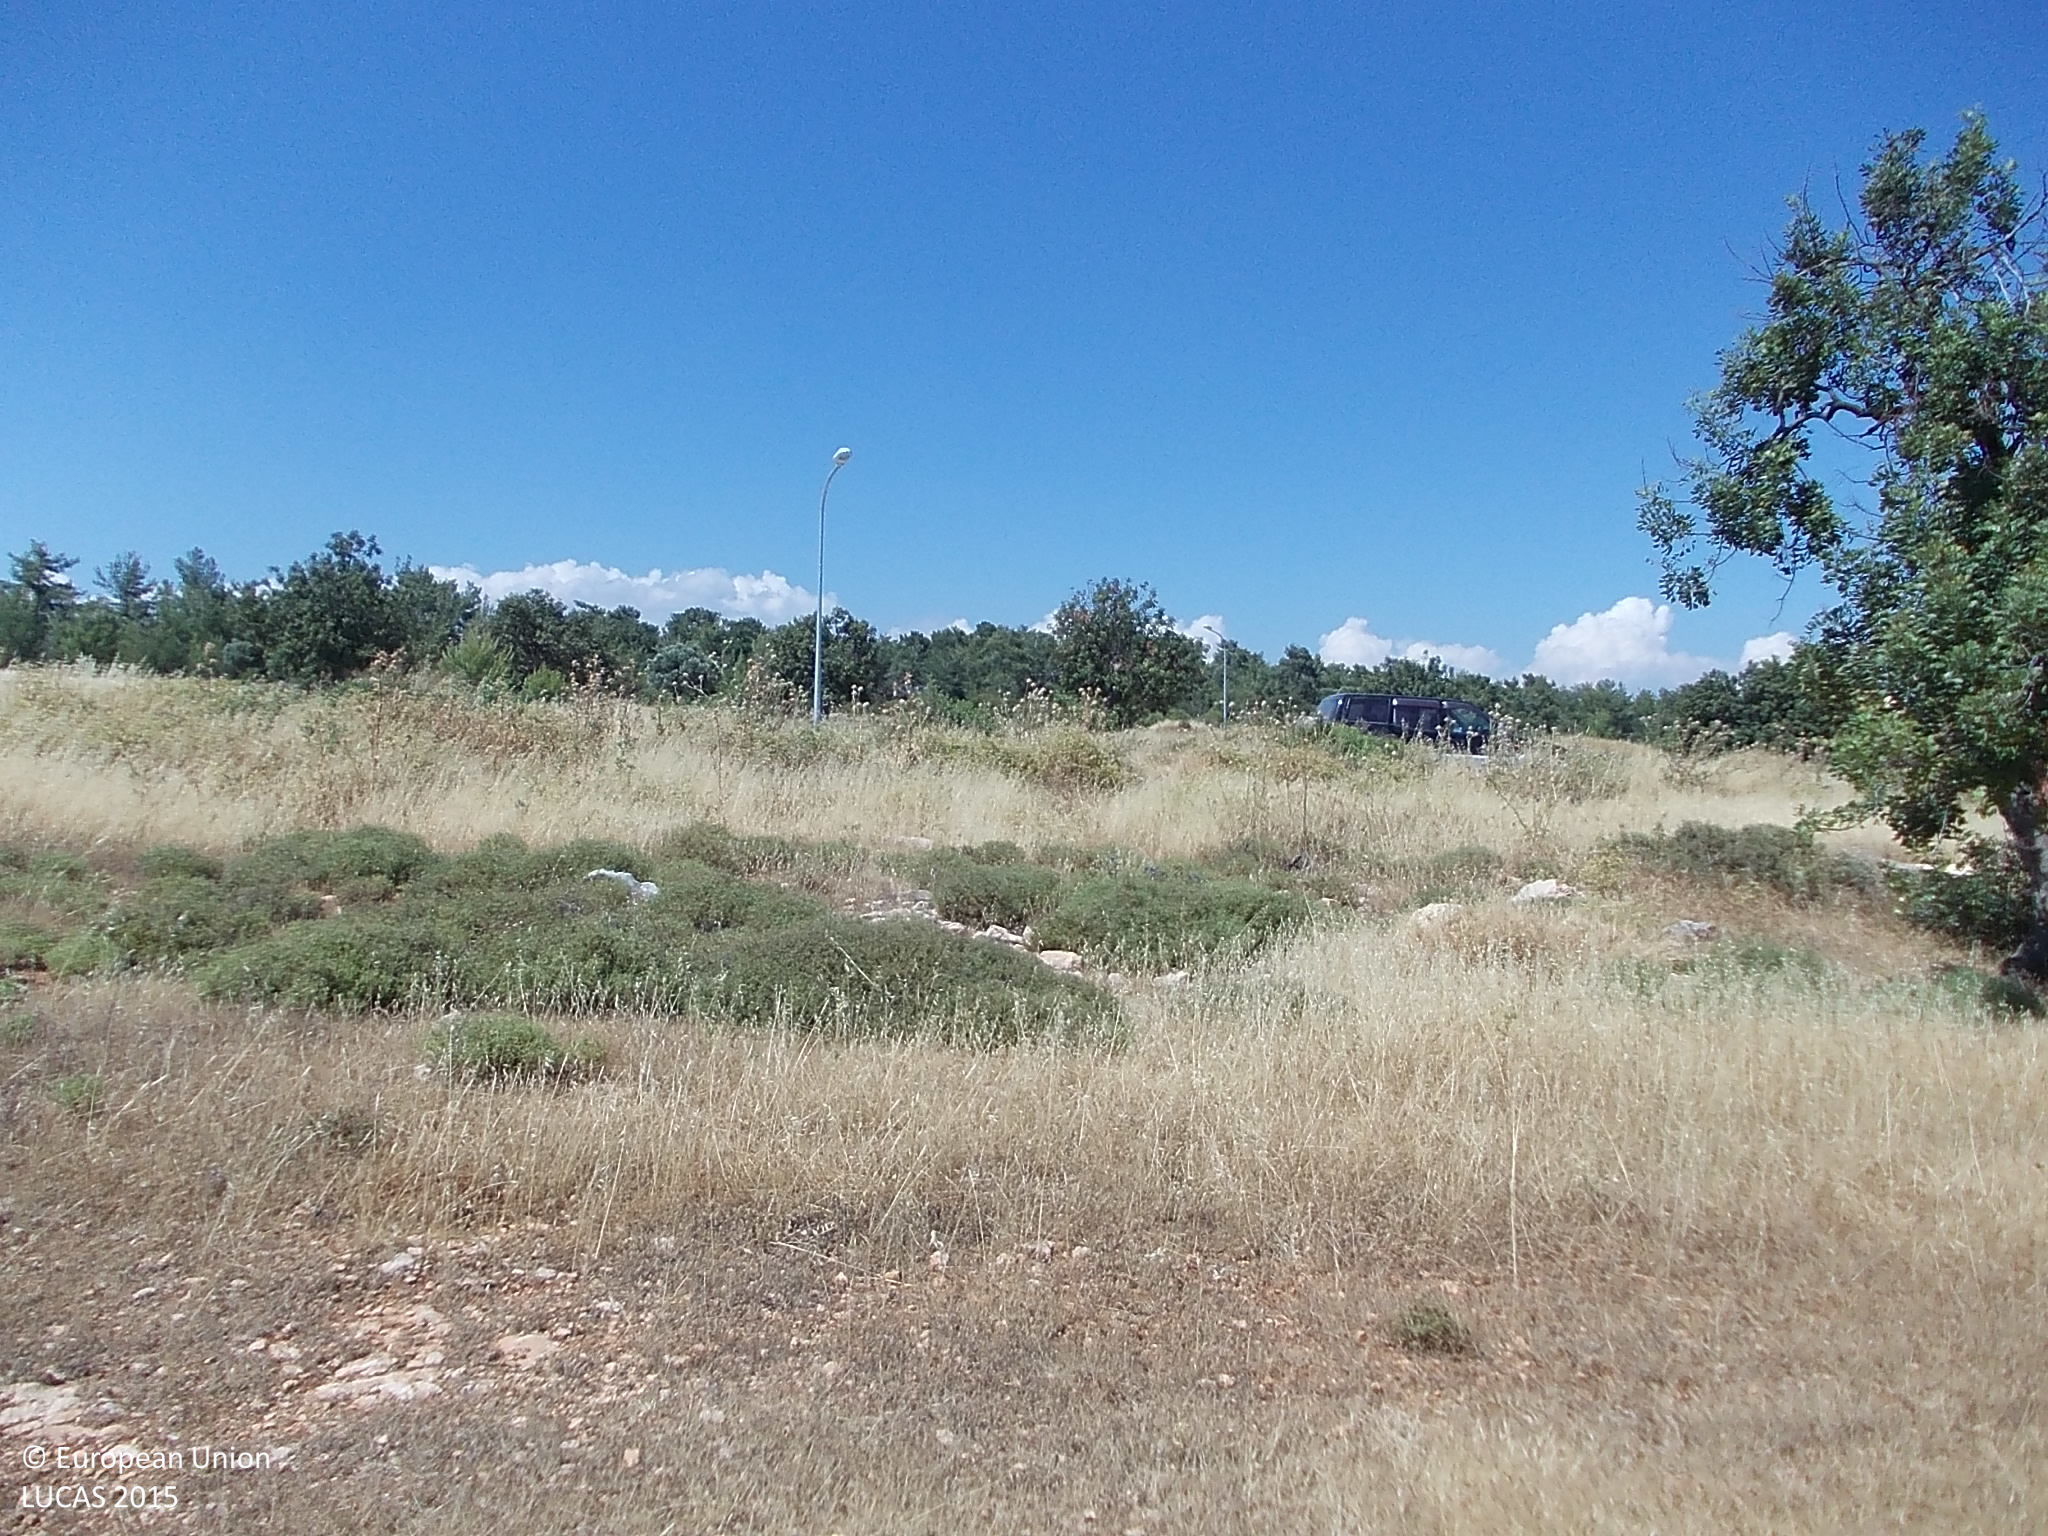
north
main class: Grassland
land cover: Grassland with sparse tree/shrub cover
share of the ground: > 75 %
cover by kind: herbaceous plants 85 %, unconsolidated bare surface 10 %, broadleaved forest trees 5 %
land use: Semi-natural and natural areas not in use
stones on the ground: 10 - 25 %
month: June
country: CY
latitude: 34.7465
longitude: 32.8923
